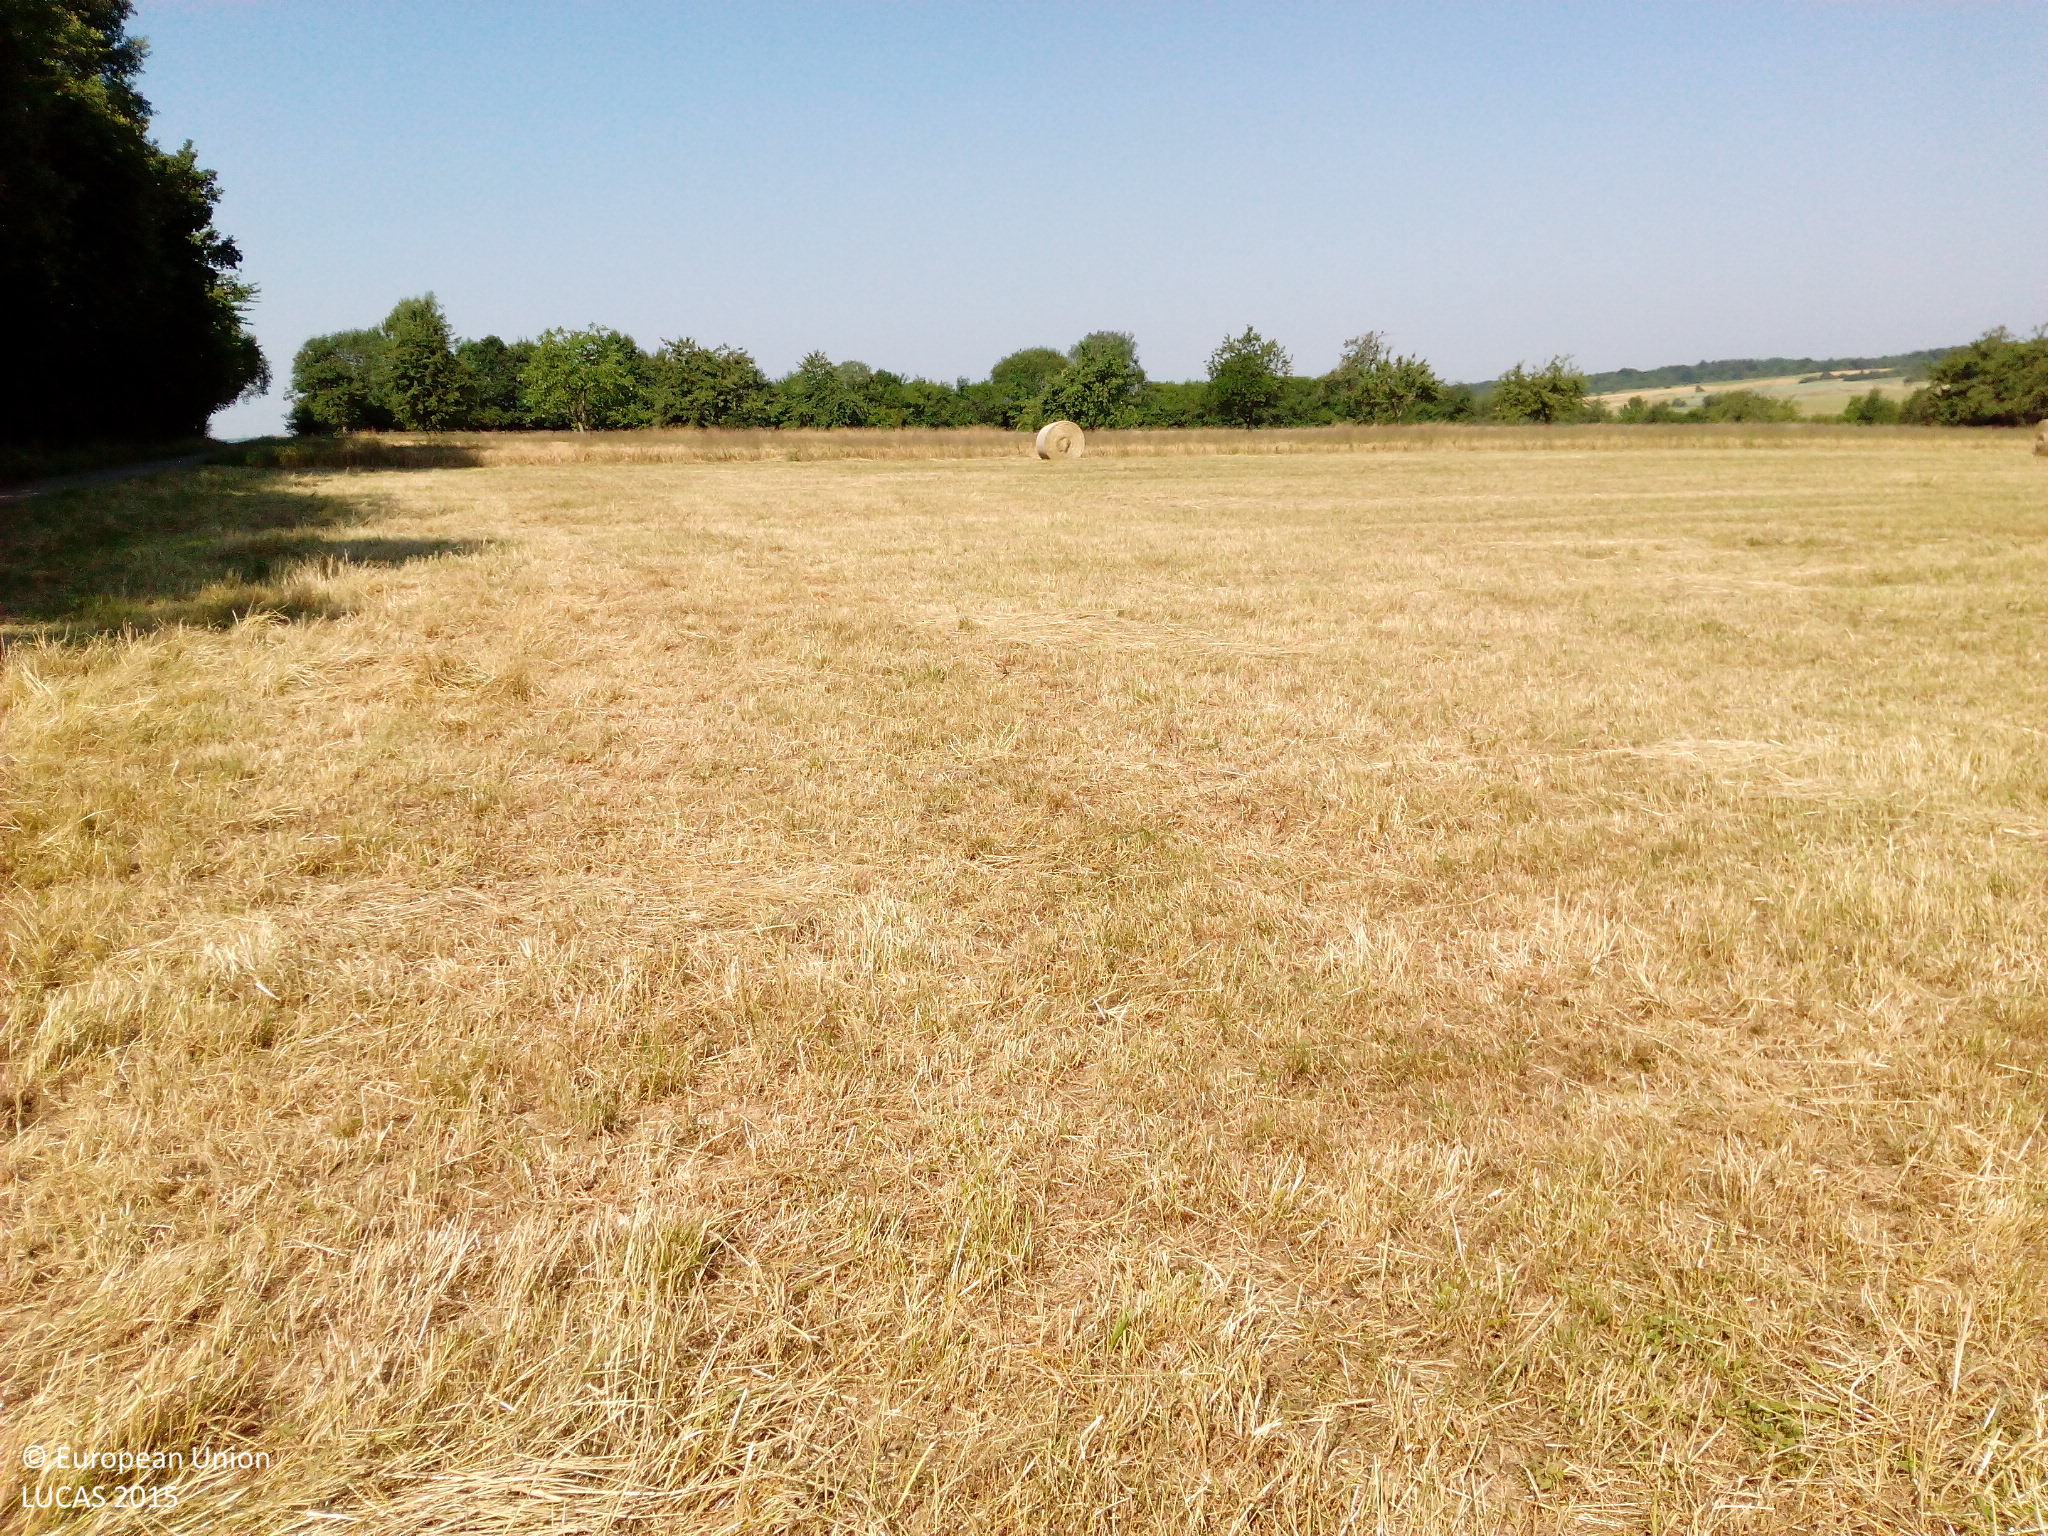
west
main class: Grassland
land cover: Grassland without tree/shrub cover
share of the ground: > 75 %
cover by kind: herbaceous plants 100 %
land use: Agriculture (excluding fallow land and kitchen gardens)
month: July
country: DE
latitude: 49.2131
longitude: 7.1588
